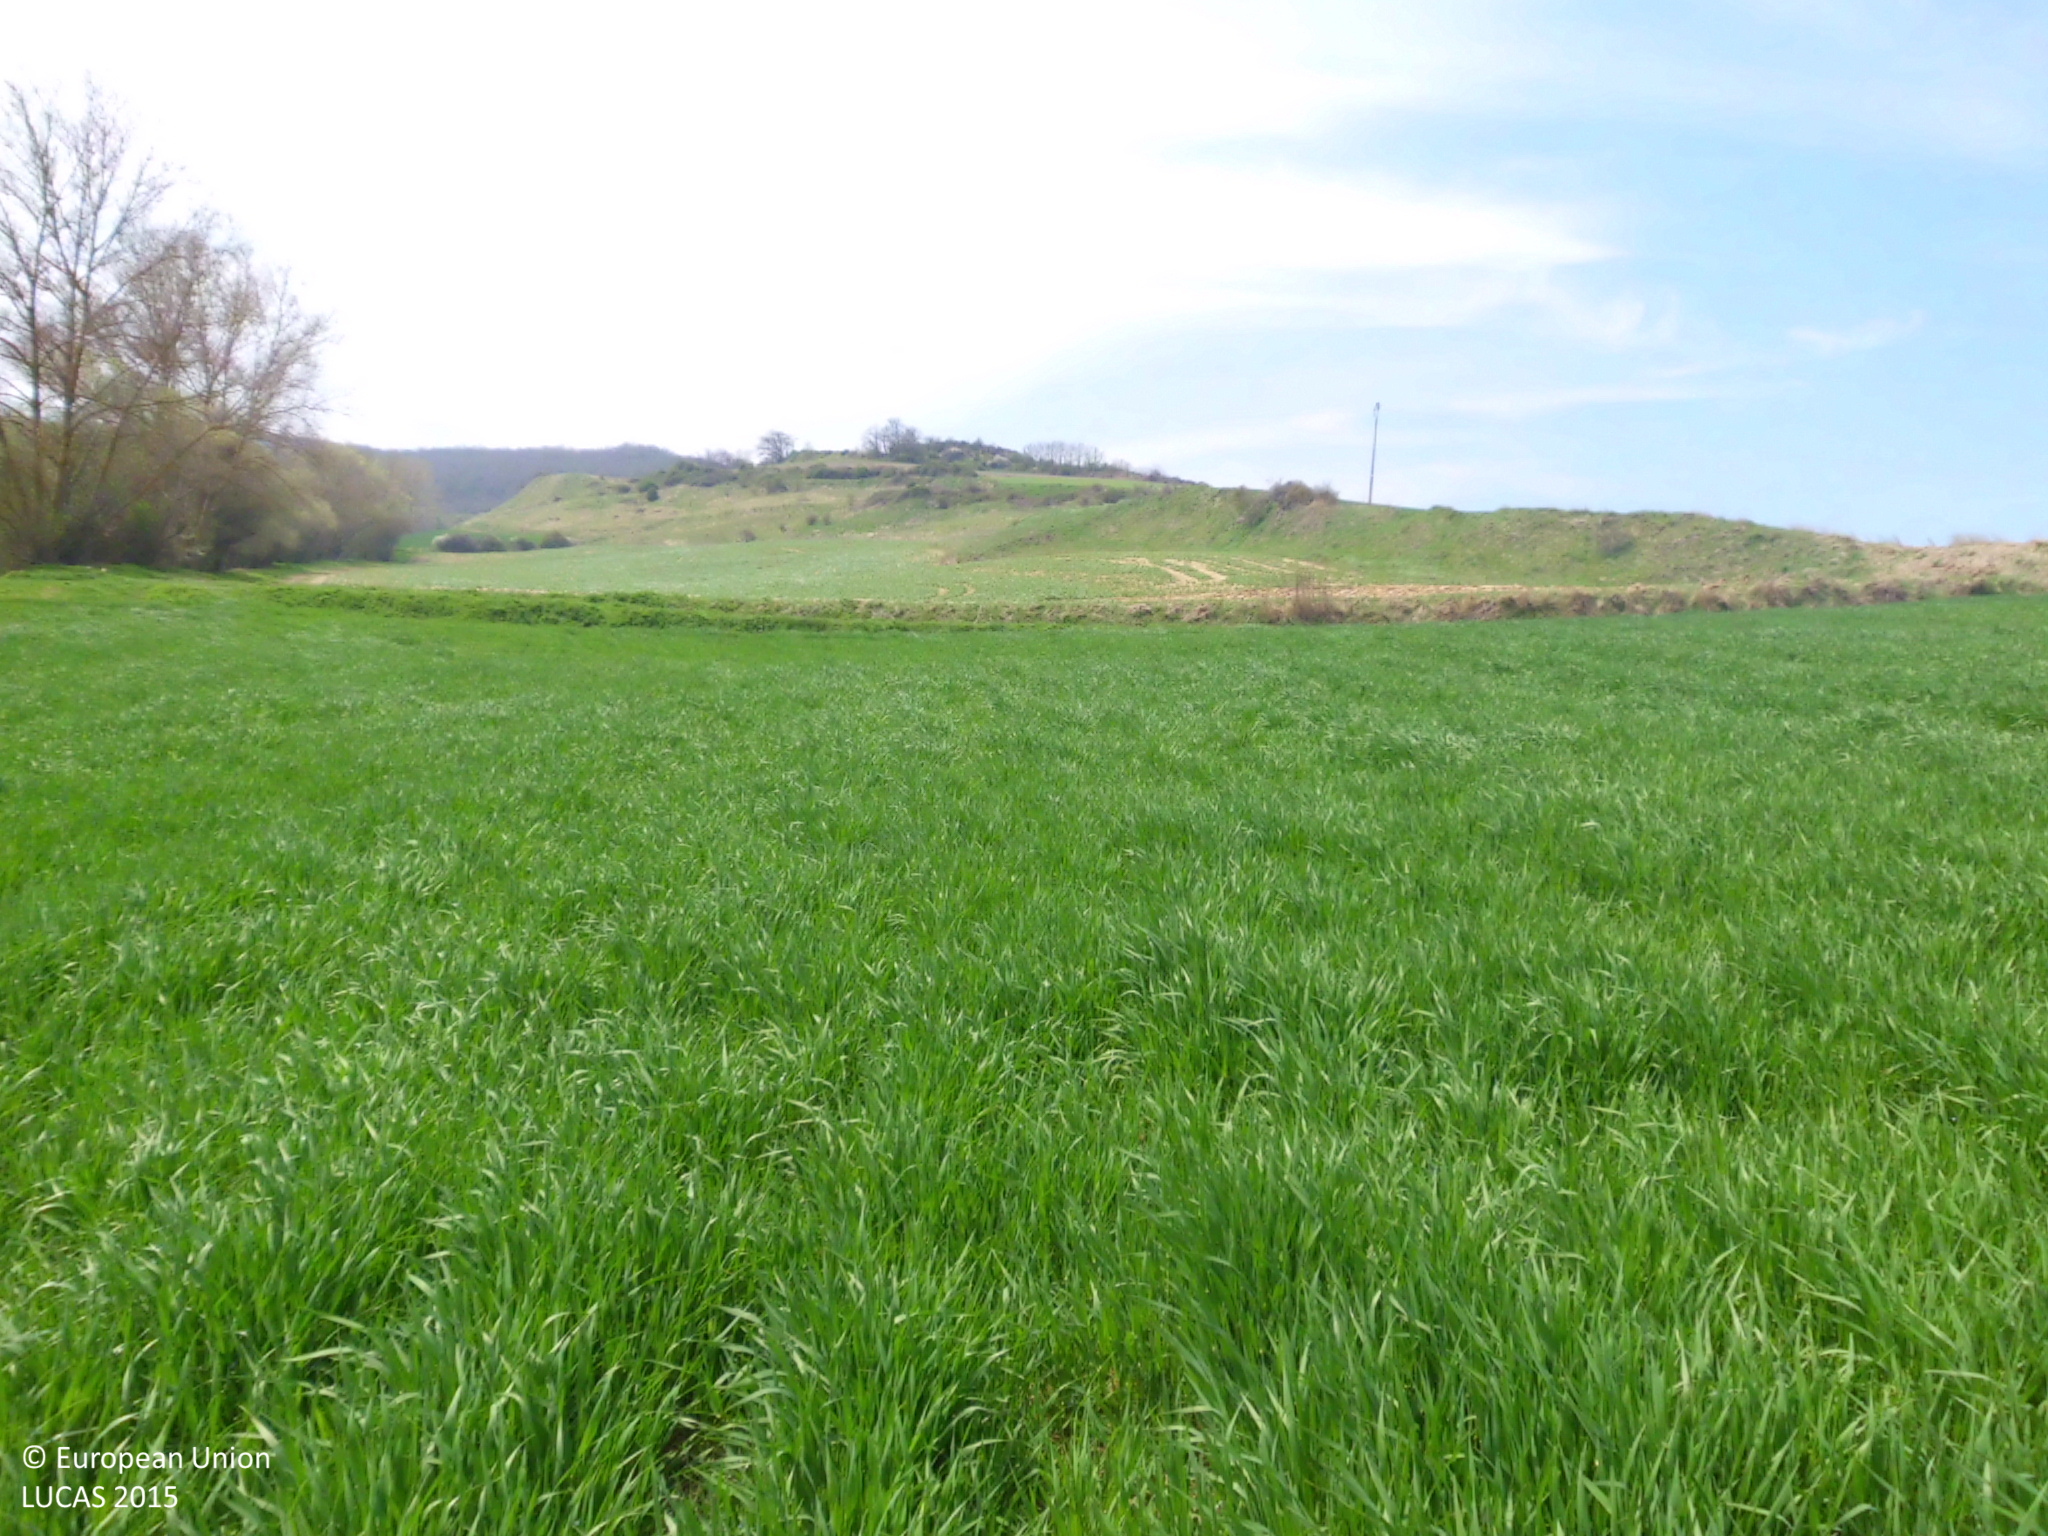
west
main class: Cropland
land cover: Barley
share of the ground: > 75 %
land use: Agriculture (excluding fallow land and kitchen gardens)
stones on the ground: < 10 %
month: April
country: ES
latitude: 42.3929
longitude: -3.3086
